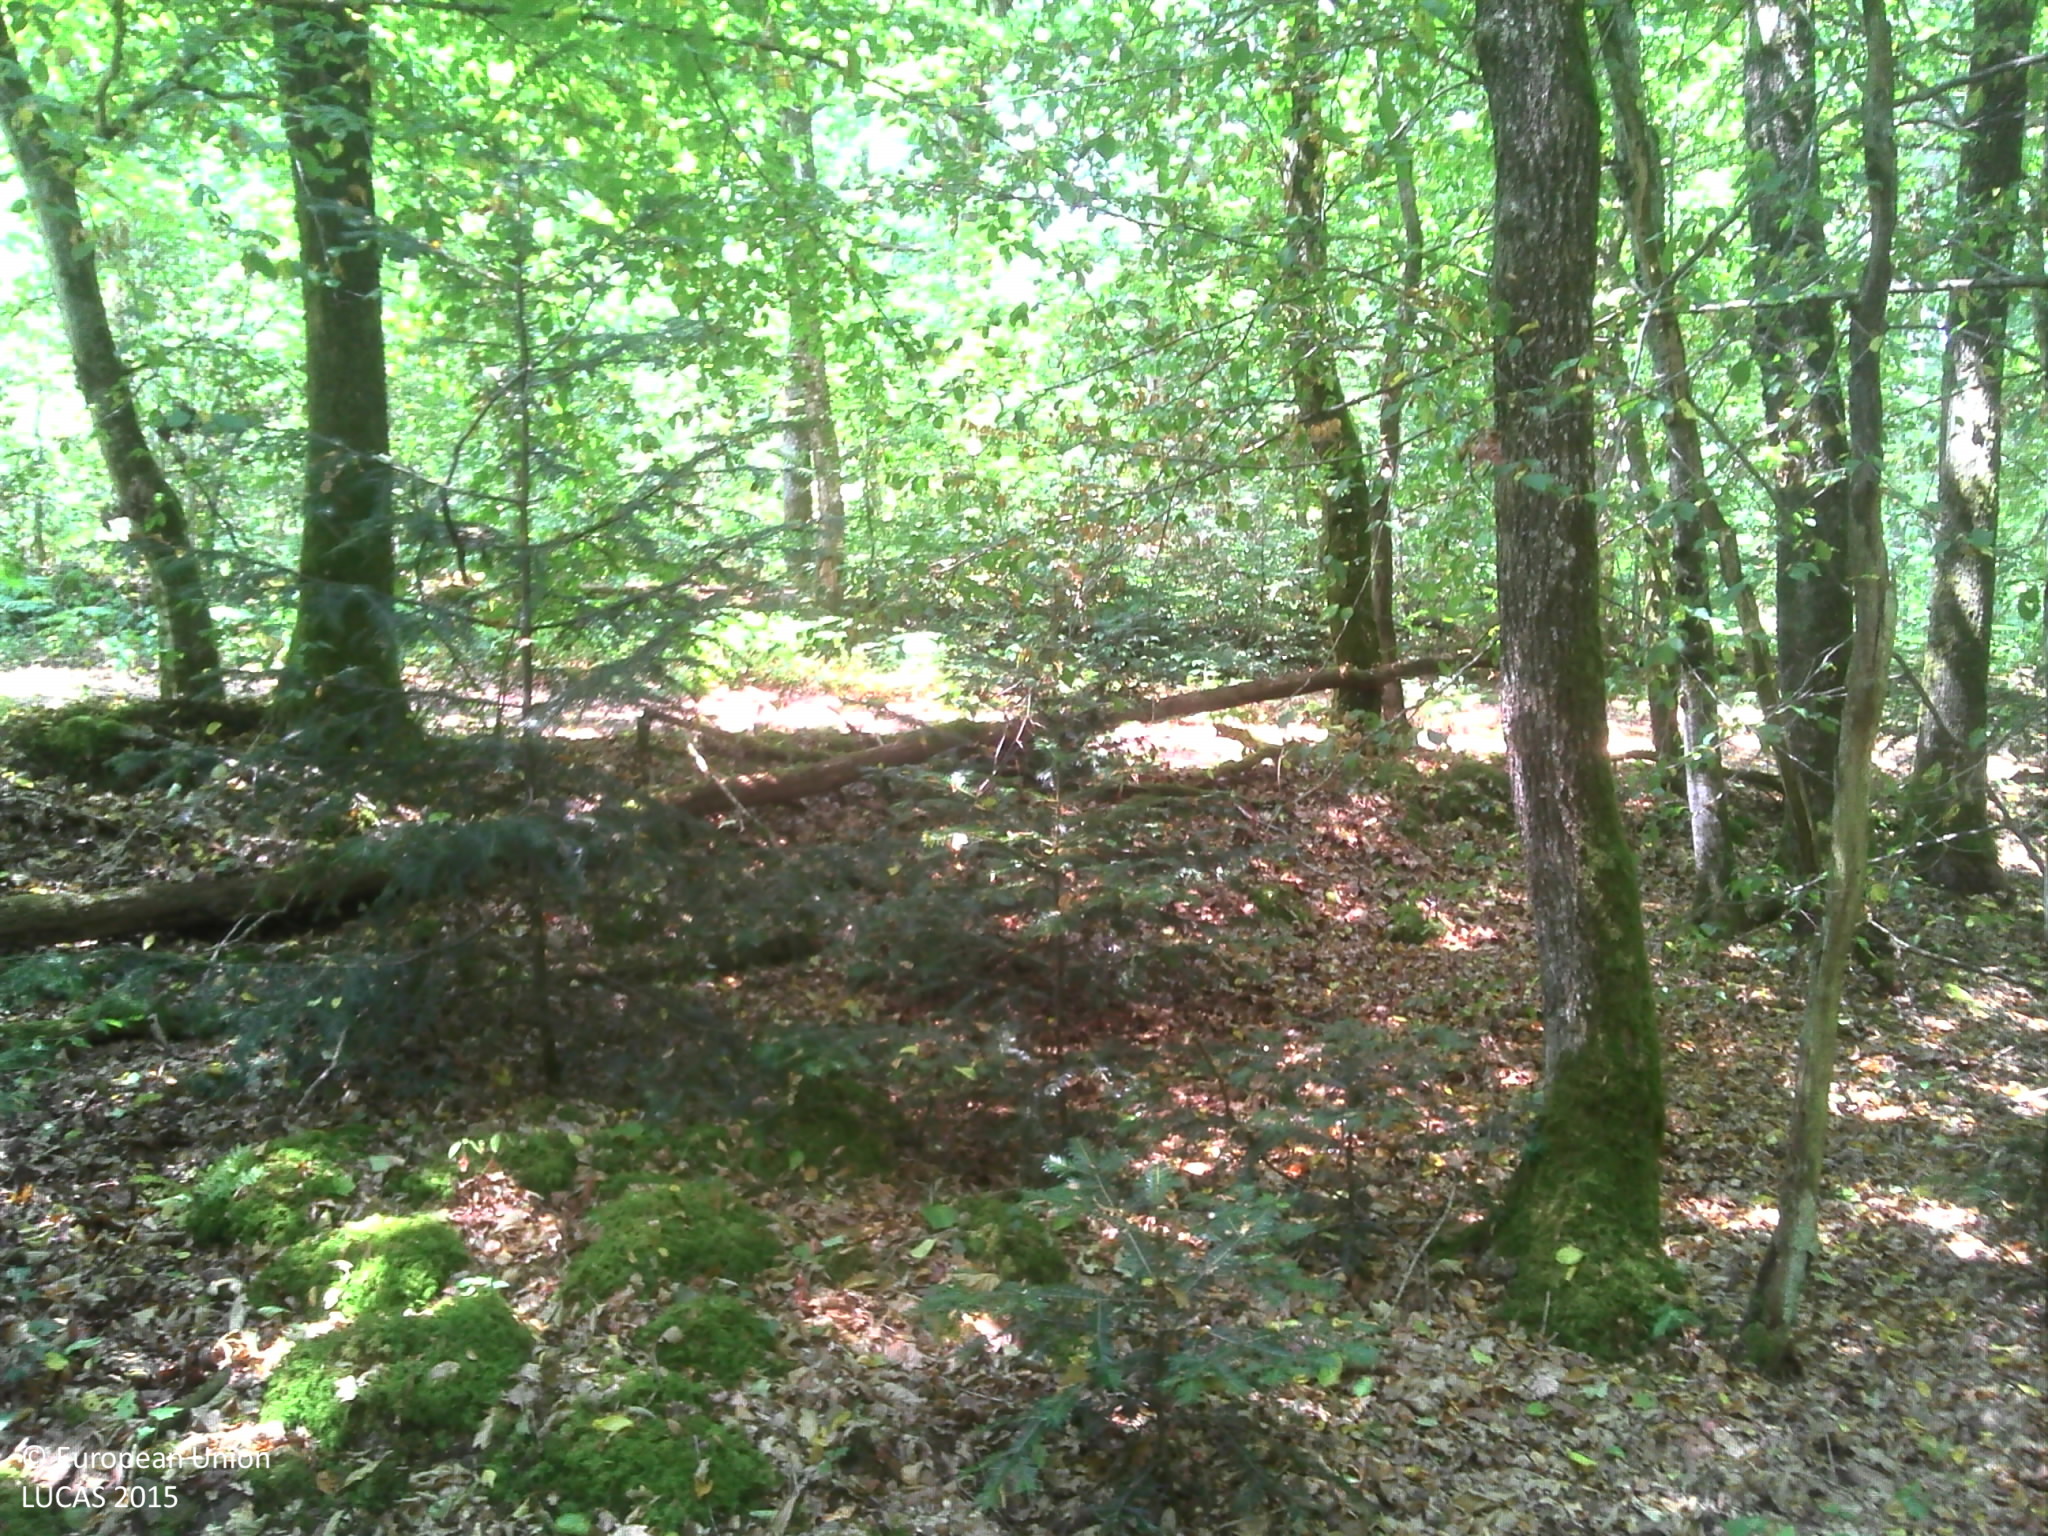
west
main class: Woodland
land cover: Broadleaved woodland
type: mesophytic deciduous forest
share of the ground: > 75 %
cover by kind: broadleaved forest trees 90 %, herbaceous plants 10 %
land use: Forestry
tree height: > 5 m
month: July
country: FR
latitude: 46.5285
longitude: 4.3820
